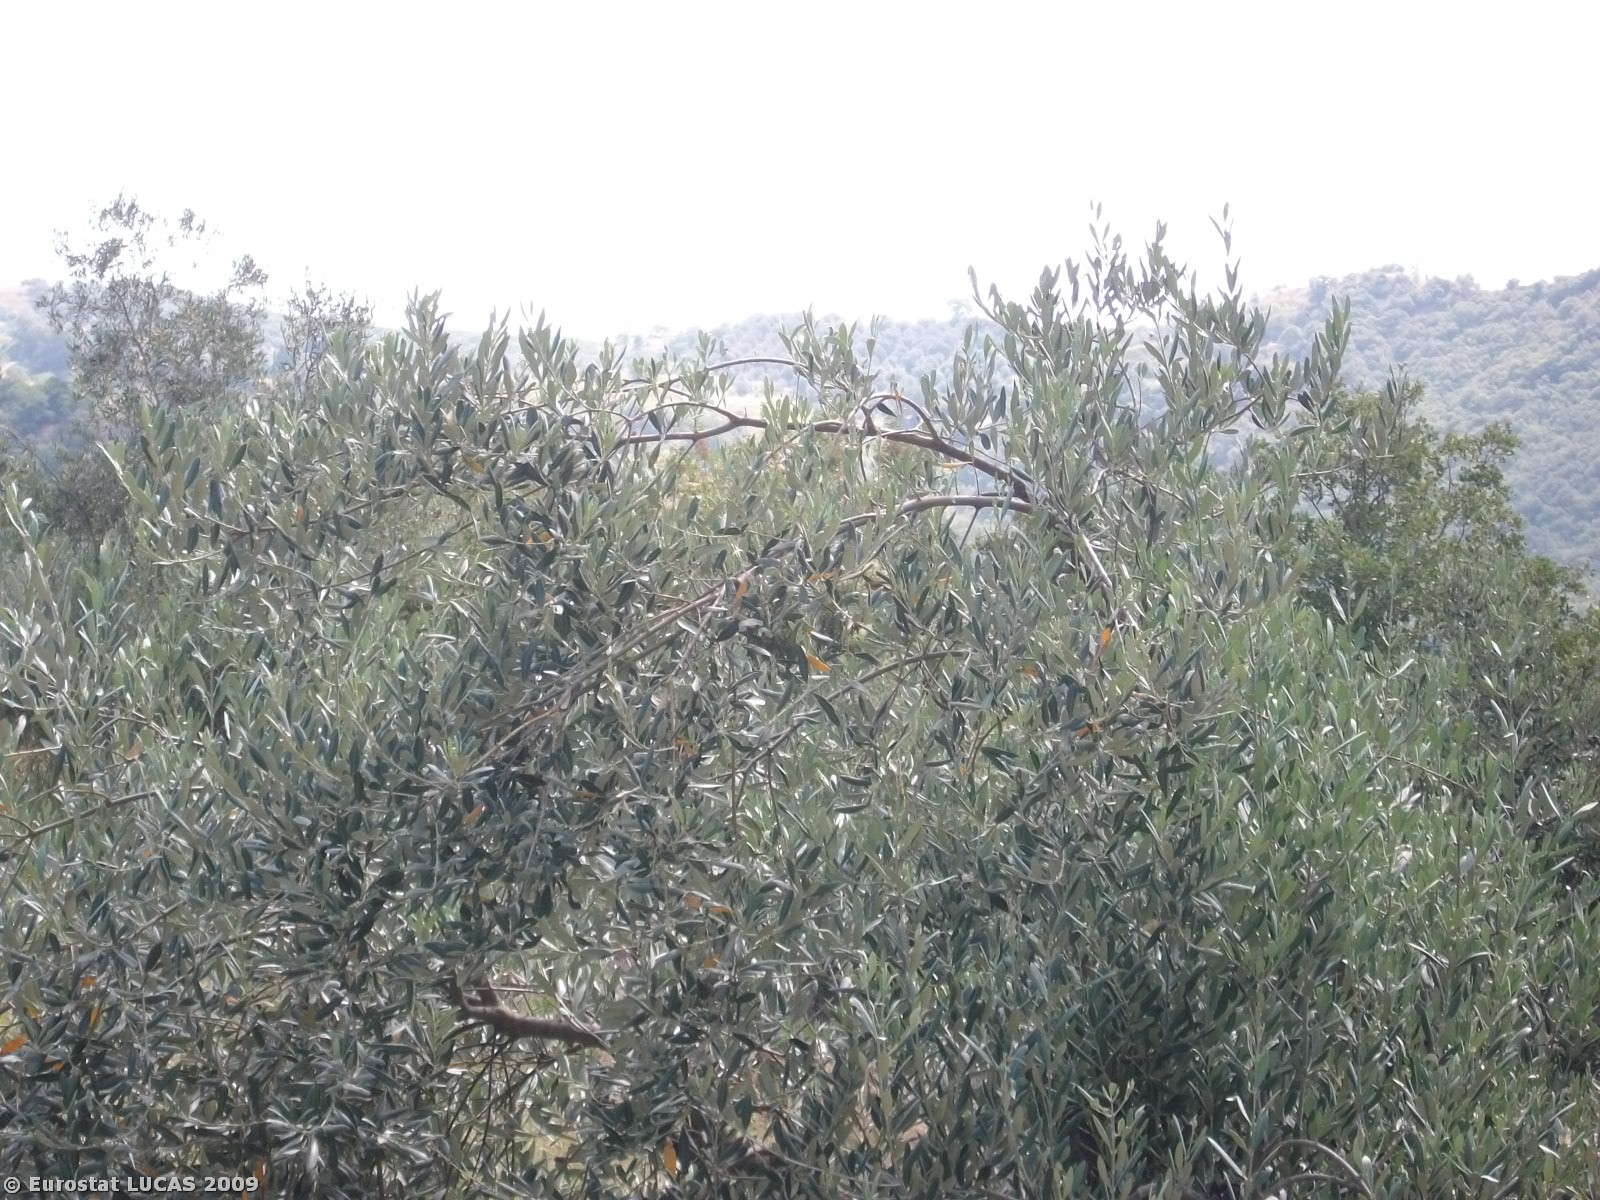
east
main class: Cropland
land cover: Olive groves
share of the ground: 25 - 50 %
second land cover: Grassland with sparse tree/shrub cover
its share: > 75 %
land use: Agriculture (excluding fallow land and kitchen gardens)
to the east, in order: Olive groves; Grassland with sparse tree/shrub cover; Bare land; Shrubland with sparse tree cover; Olive groves; Grassland with sparse tree/shrub cover; Shrubland with sparse tree cover; Grassland without tree/shrub cover; Shrubland with sparse tree cover
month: August
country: GR
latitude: 38.7645
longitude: 22.6751
